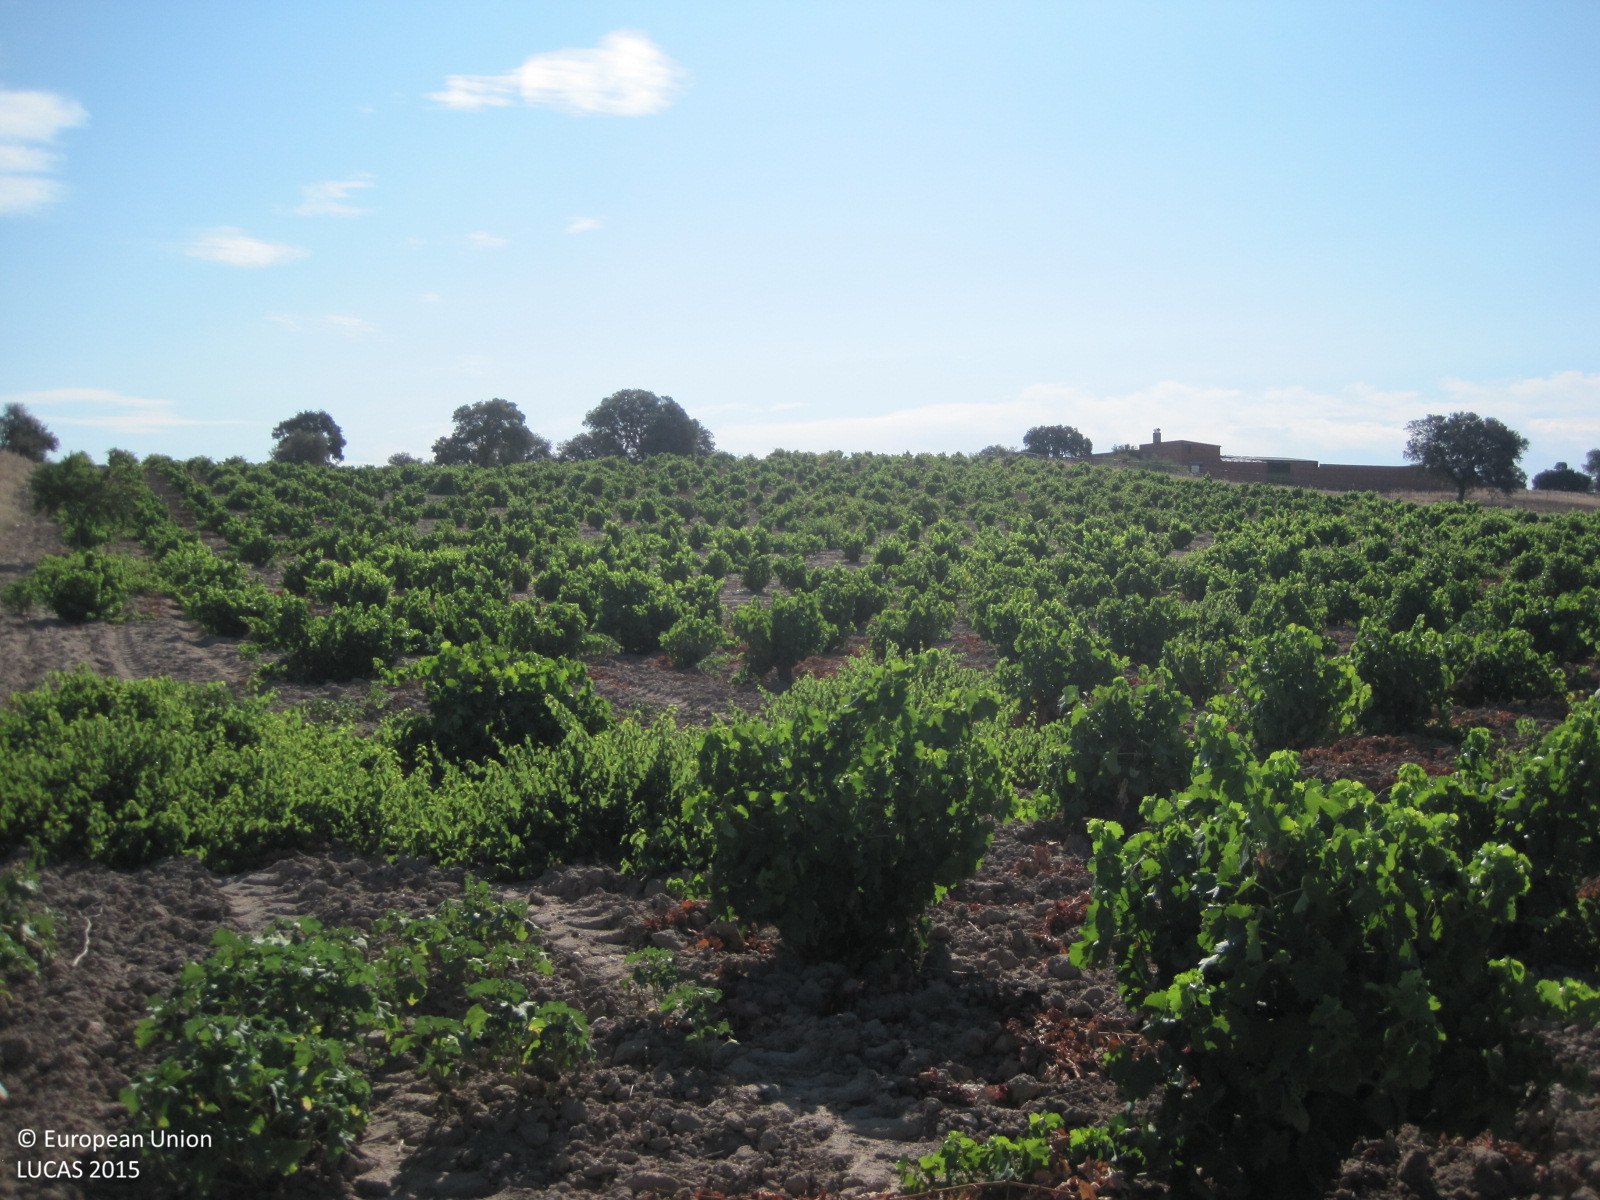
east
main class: Cropland
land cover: Vineyards
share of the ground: 25 - 50 %
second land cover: Other bare soil
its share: > 75 %
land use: Agriculture (excluding fallow land and kitchen gardens)
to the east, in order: Vineyards; Other bare soil; Fences; Grass margins; Tracks; Grass margins; Vineyards
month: July
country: ES
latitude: 40.1382
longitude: -4.3741
